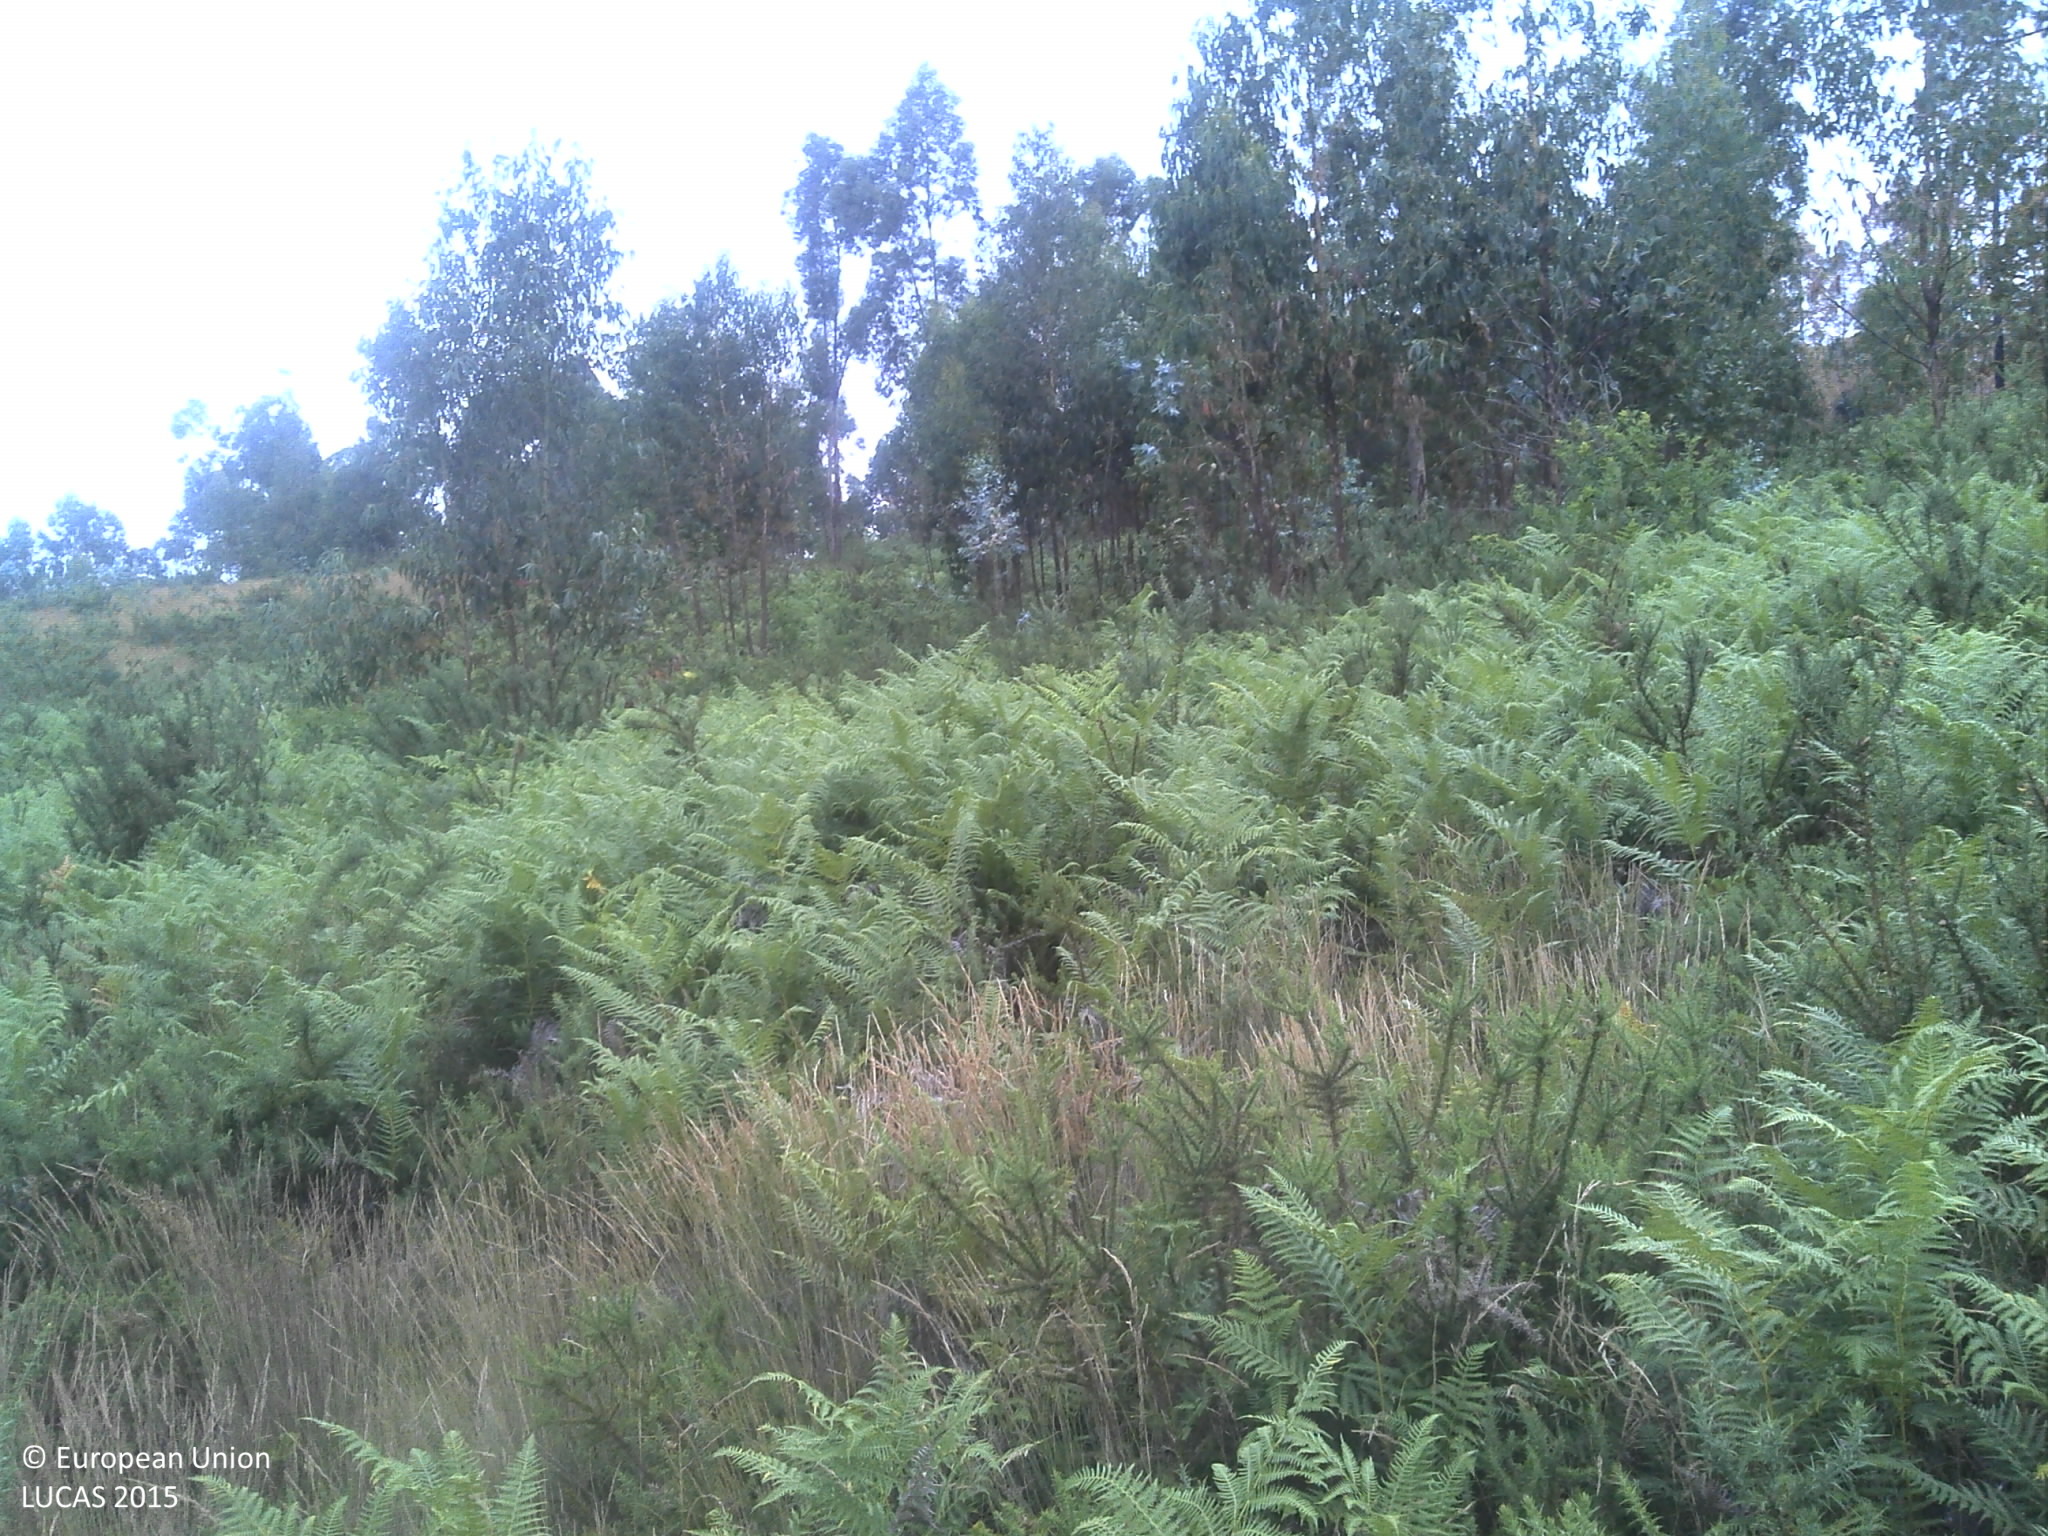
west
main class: Shrubland
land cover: Shrubland with sparse tree cover
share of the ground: 50 - 75 %
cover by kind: shrubs 75 %, herbaceous plants 15 %, broadleaved forest trees 5 %, unconsolidated bare surface 5 %
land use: Forestry
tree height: > 5 m
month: June
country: PT
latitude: 41.2521
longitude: -8.2723
